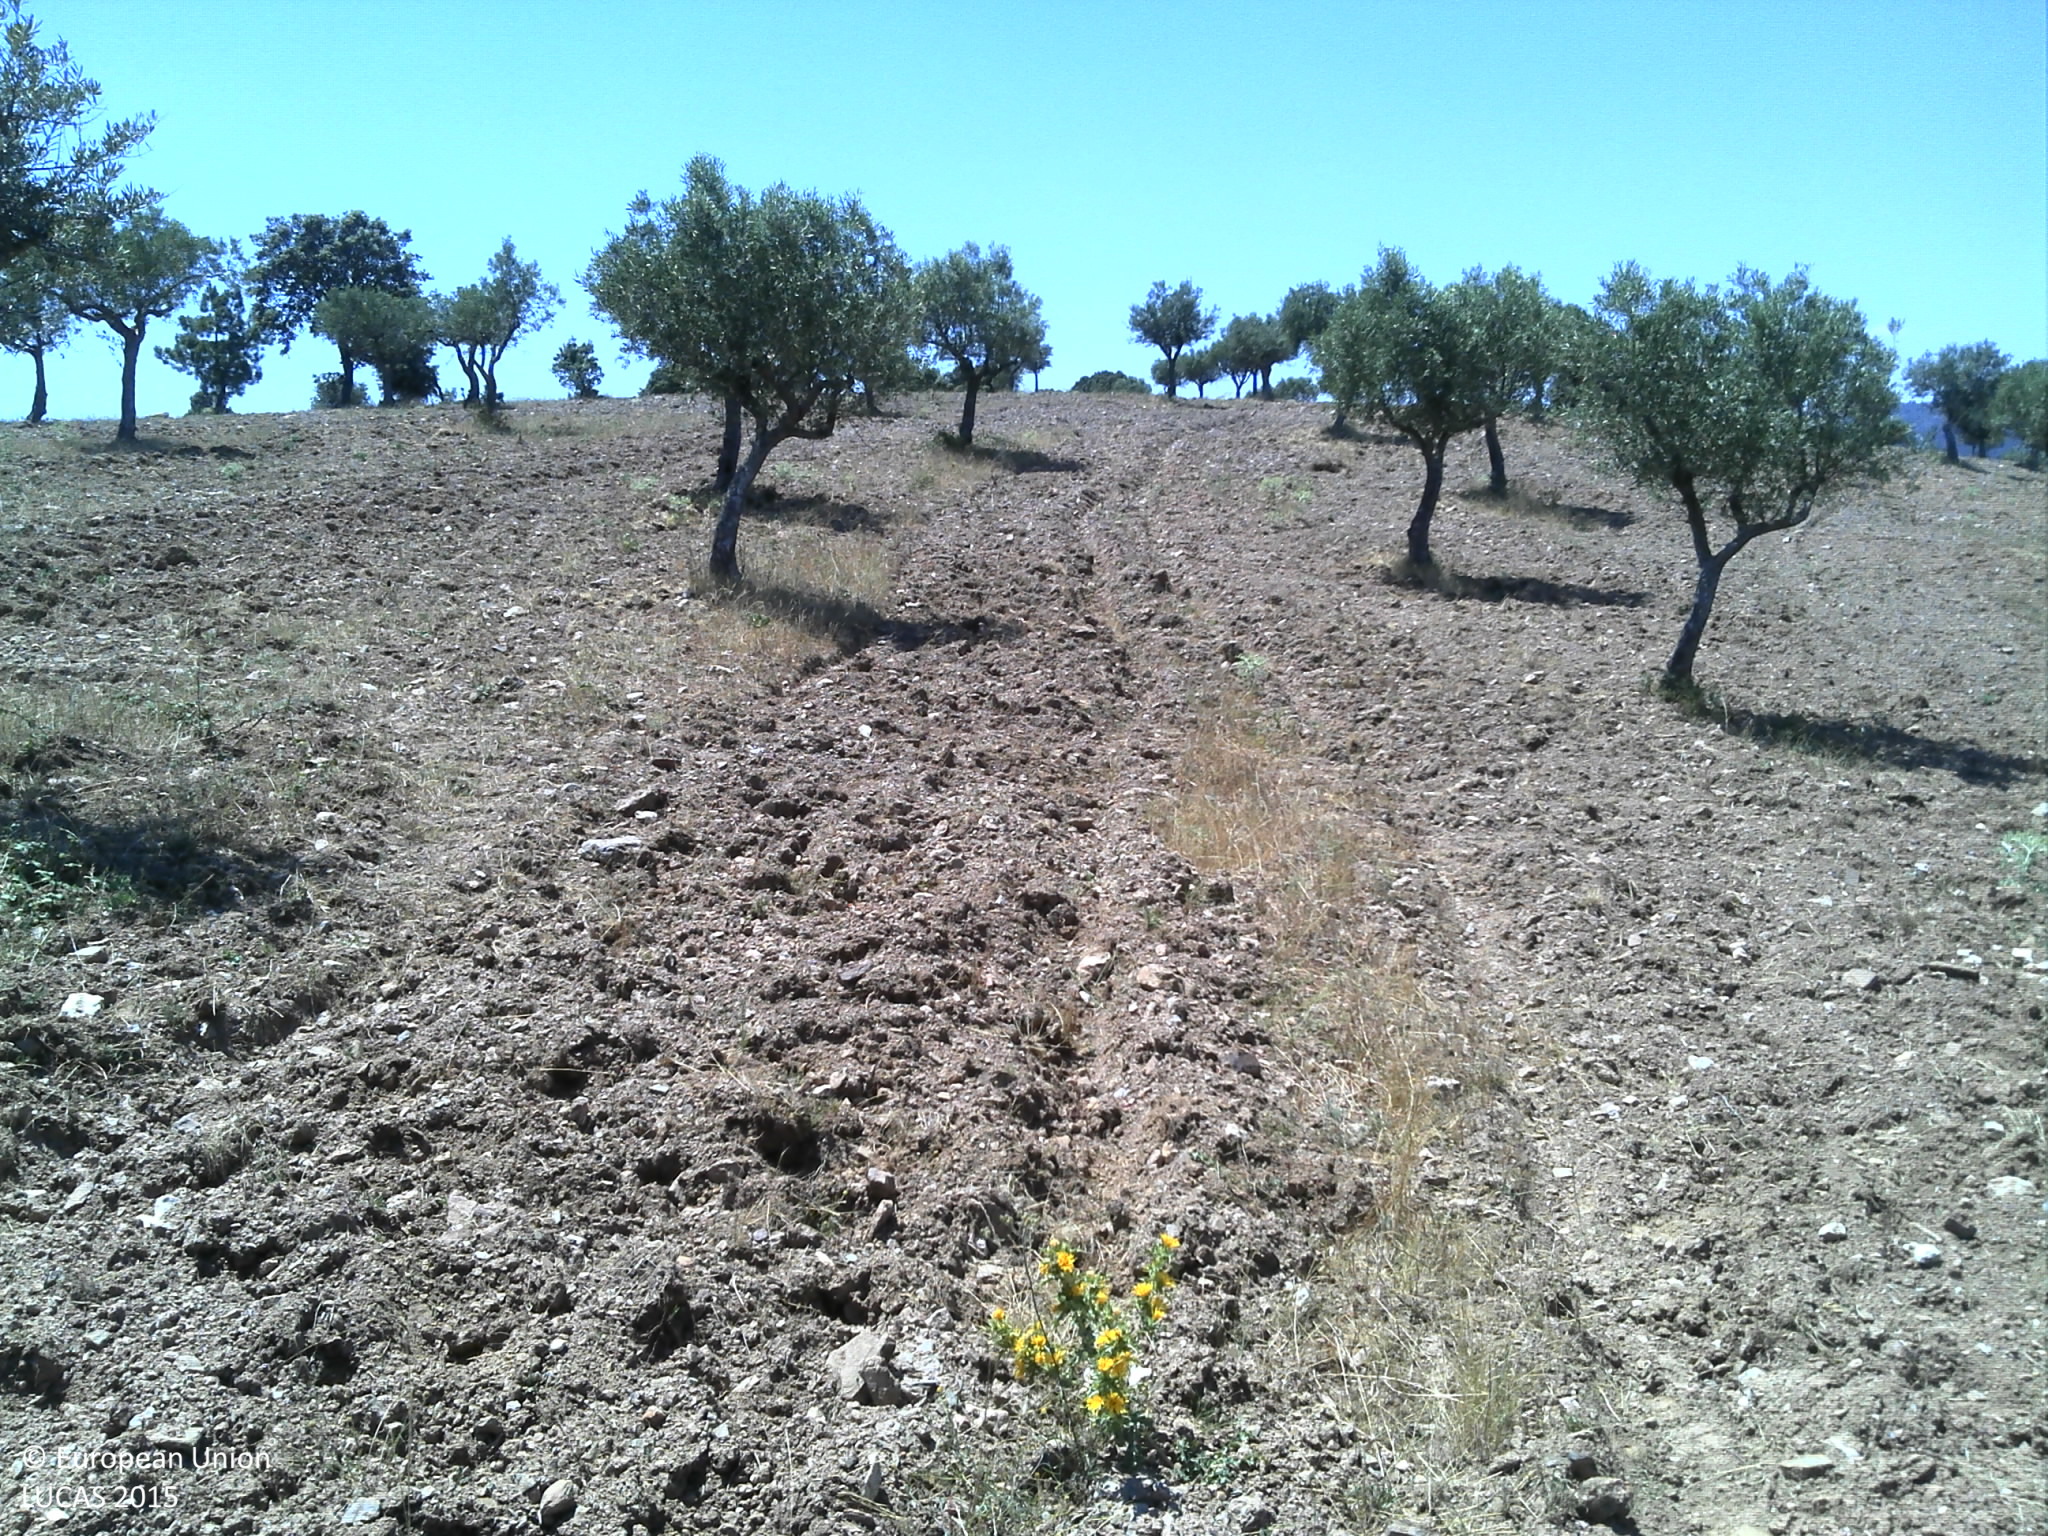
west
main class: Cropland
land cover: Olive groves
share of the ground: 10 - 25 %
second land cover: Other bare soil
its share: > 75 %
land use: Agriculture (excluding fallow land and kitchen gardens)
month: June
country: PT
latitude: 40.8395
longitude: -6.9803
